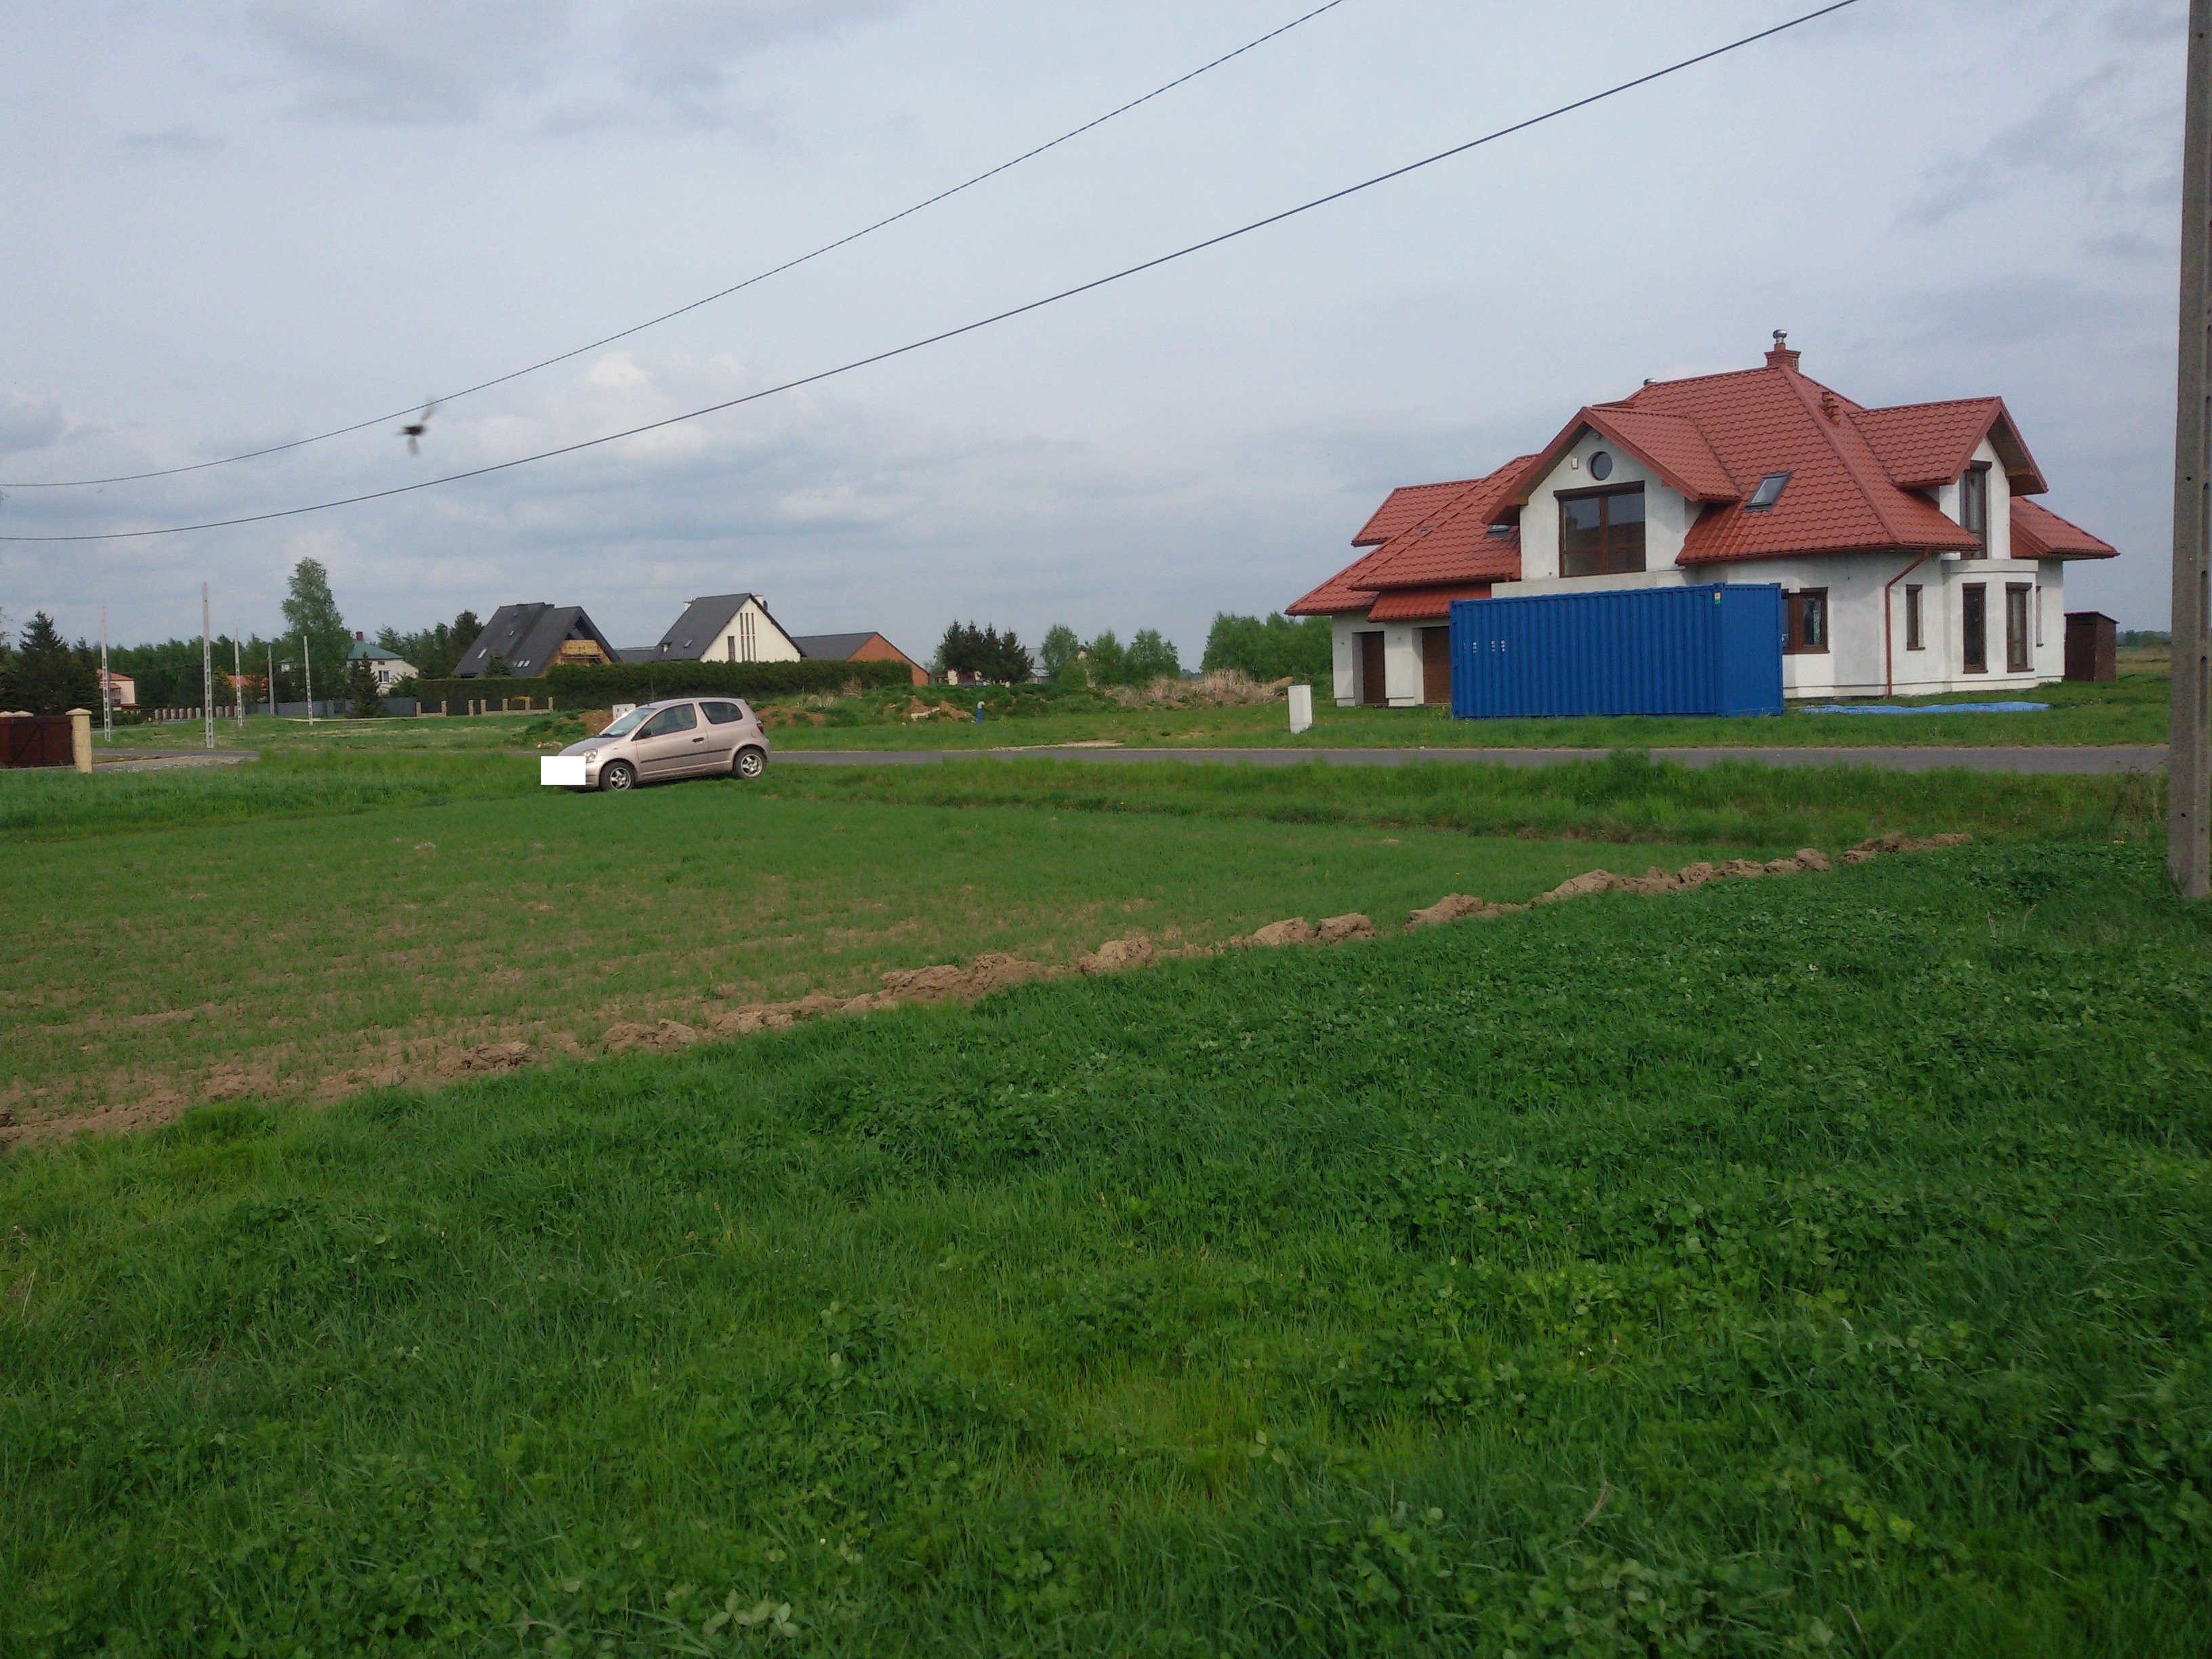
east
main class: Grassland
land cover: Grassland without tree/shrub cover
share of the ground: > 75 %
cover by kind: herbaceous plants 100 %
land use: Agriculture (excluding fallow land and kitchen gardens)
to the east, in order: Grassland without tree/shrub cover; Electric lines; Triticale; Ditches and canals; Grass margins; Artificial constructions in urban areas; Grass margins; Ditches and canals; Grassland without tree/shrub cover; Artificial constructions in urban areas; Grassland without tree/shrub cover; Clovers; Grass margins; Common wheat; Grass margins; Ditches and canals; Tracks; Grassland without tree/shrub cover; Broadleaved woodland; Ditches and canals; Spontaneously vegetated surfaces; Common wheat
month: May
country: PL
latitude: 50.3055
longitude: 21.3511
